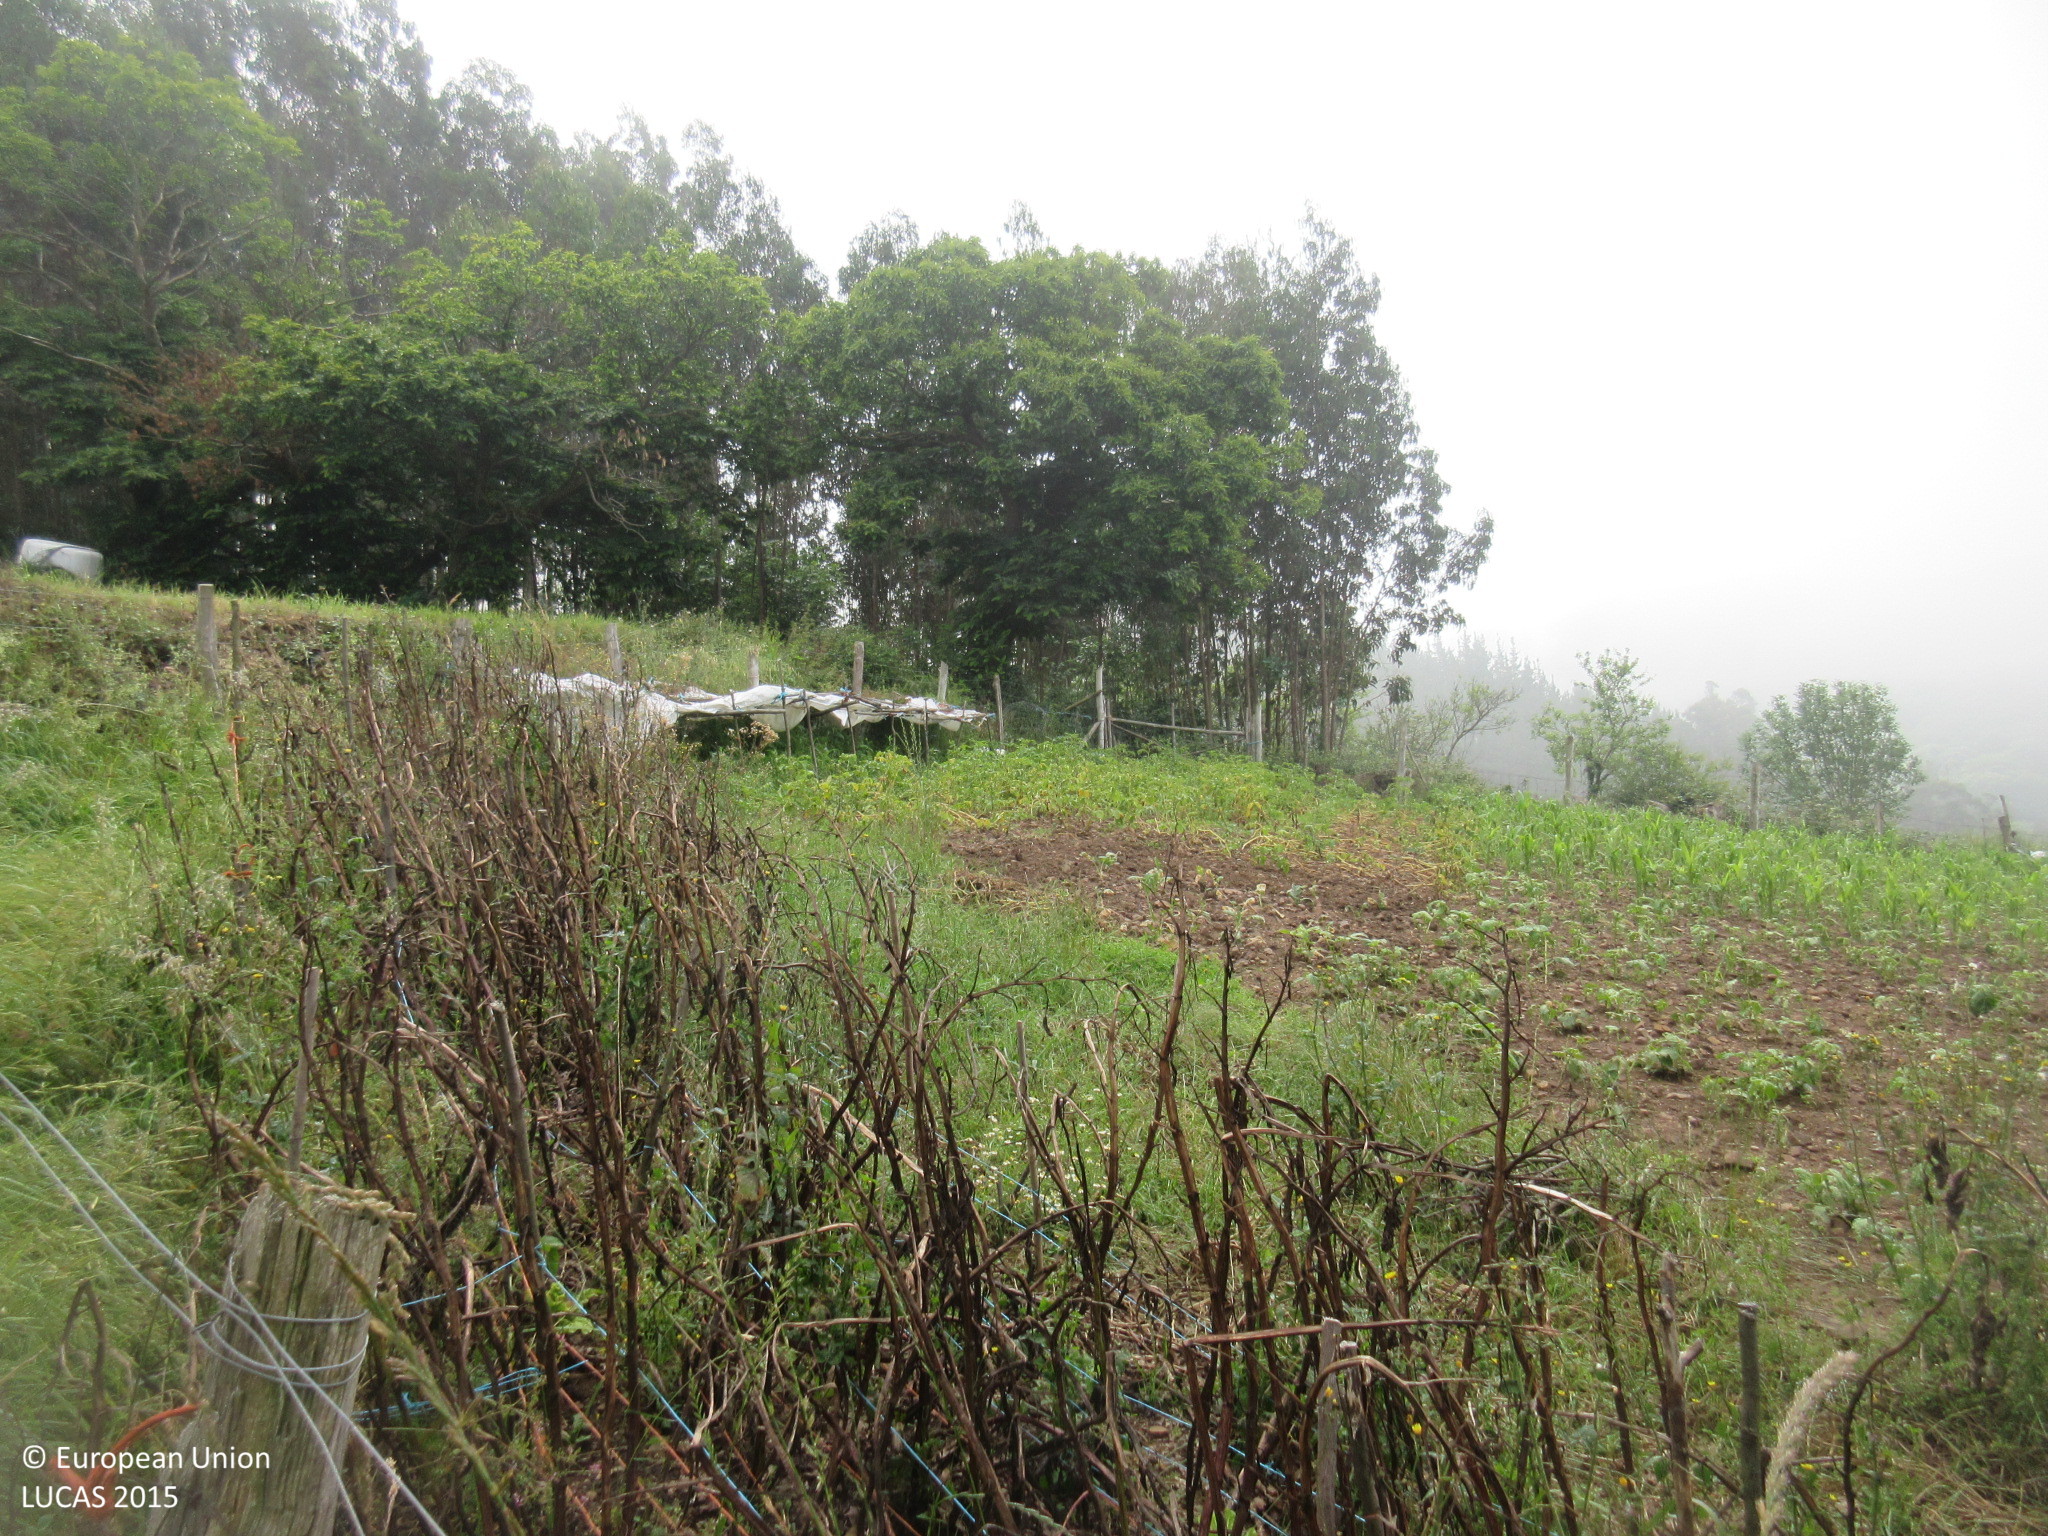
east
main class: Grassland
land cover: Grassland without tree/shrub cover
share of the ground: > 75 %
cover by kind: herbaceous plants 100 %
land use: Agriculture (excluding fallow land and kitchen gardens)
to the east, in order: Grassland without tree/shrub cover; Dry stone walls; Fences; Grass margins; Dry pulses; Maize; Fences; Tracks; Broadleaved woodland; Fences; Grassland without tree/shrub cover; Fences; Broadleaved woodland
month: June
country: ES
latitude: 43.4237
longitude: -6.0391
